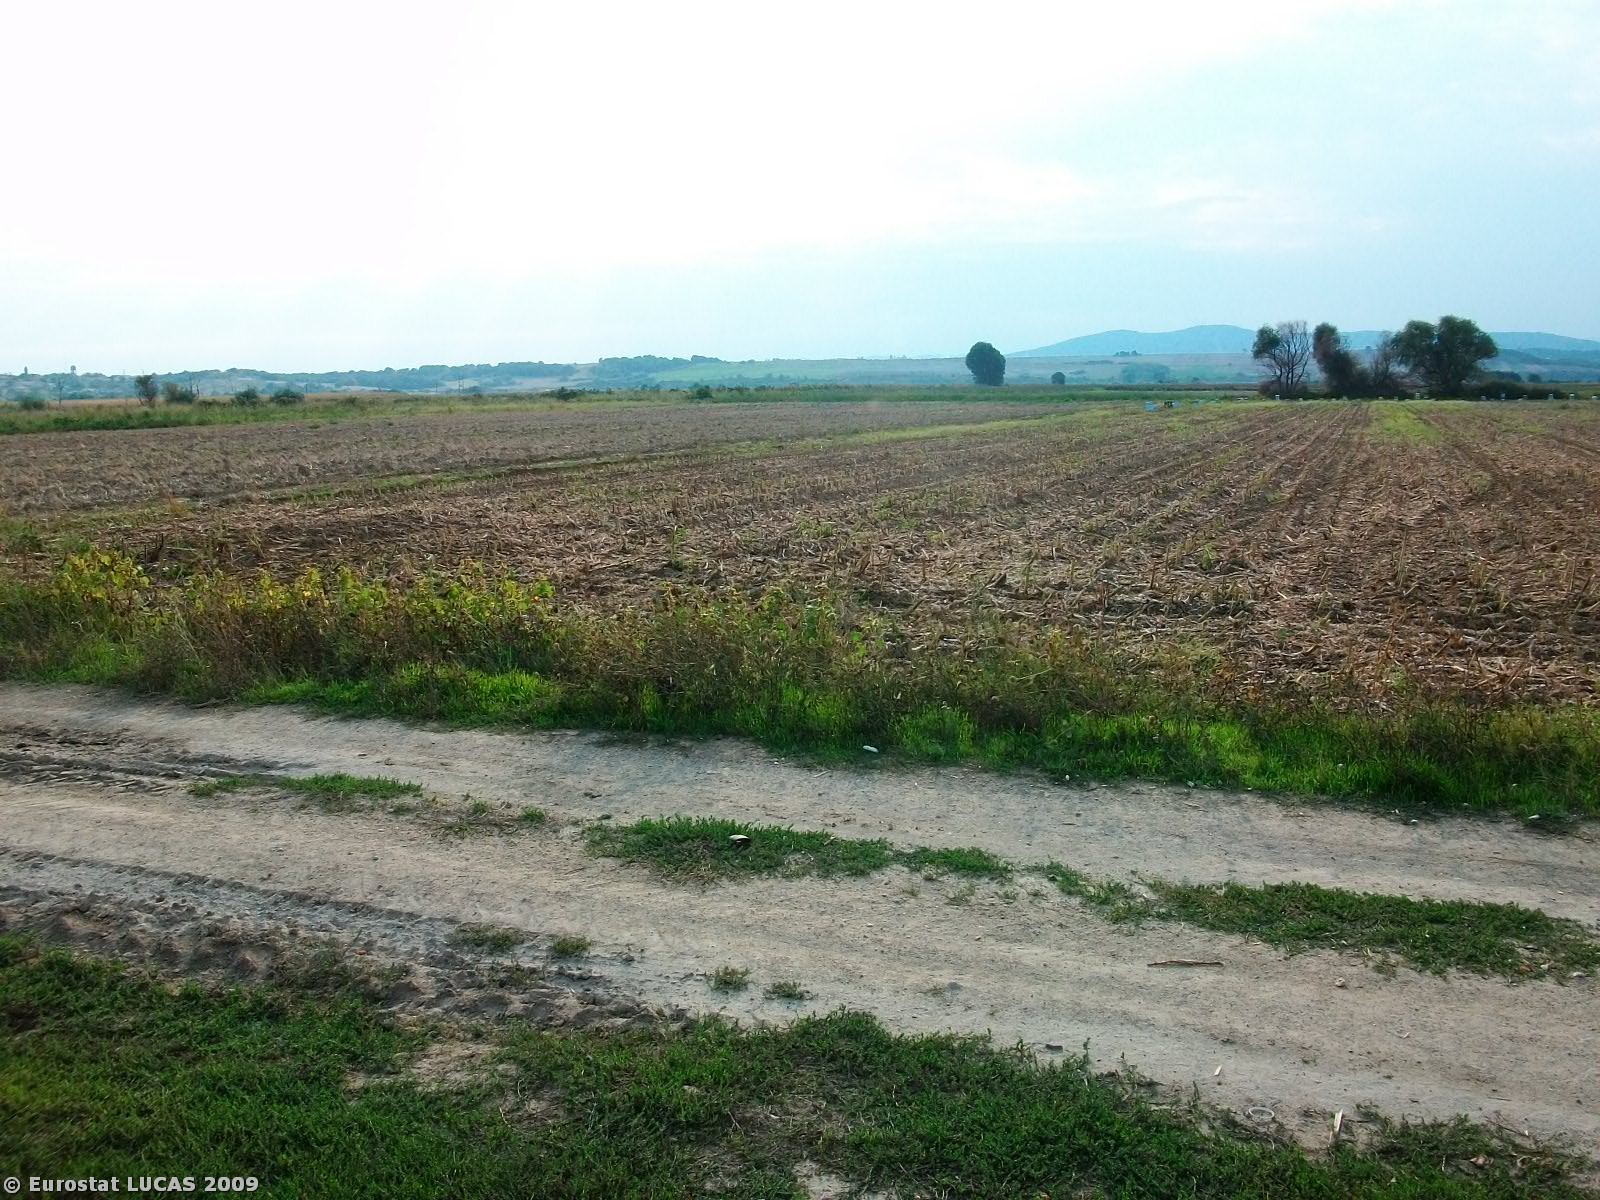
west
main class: Cropland
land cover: Cotton
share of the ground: > 75 %
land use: Agriculture (excluding fallow land and kitchen gardens)
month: September
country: GR
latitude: 41.0461
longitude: 26.3070
